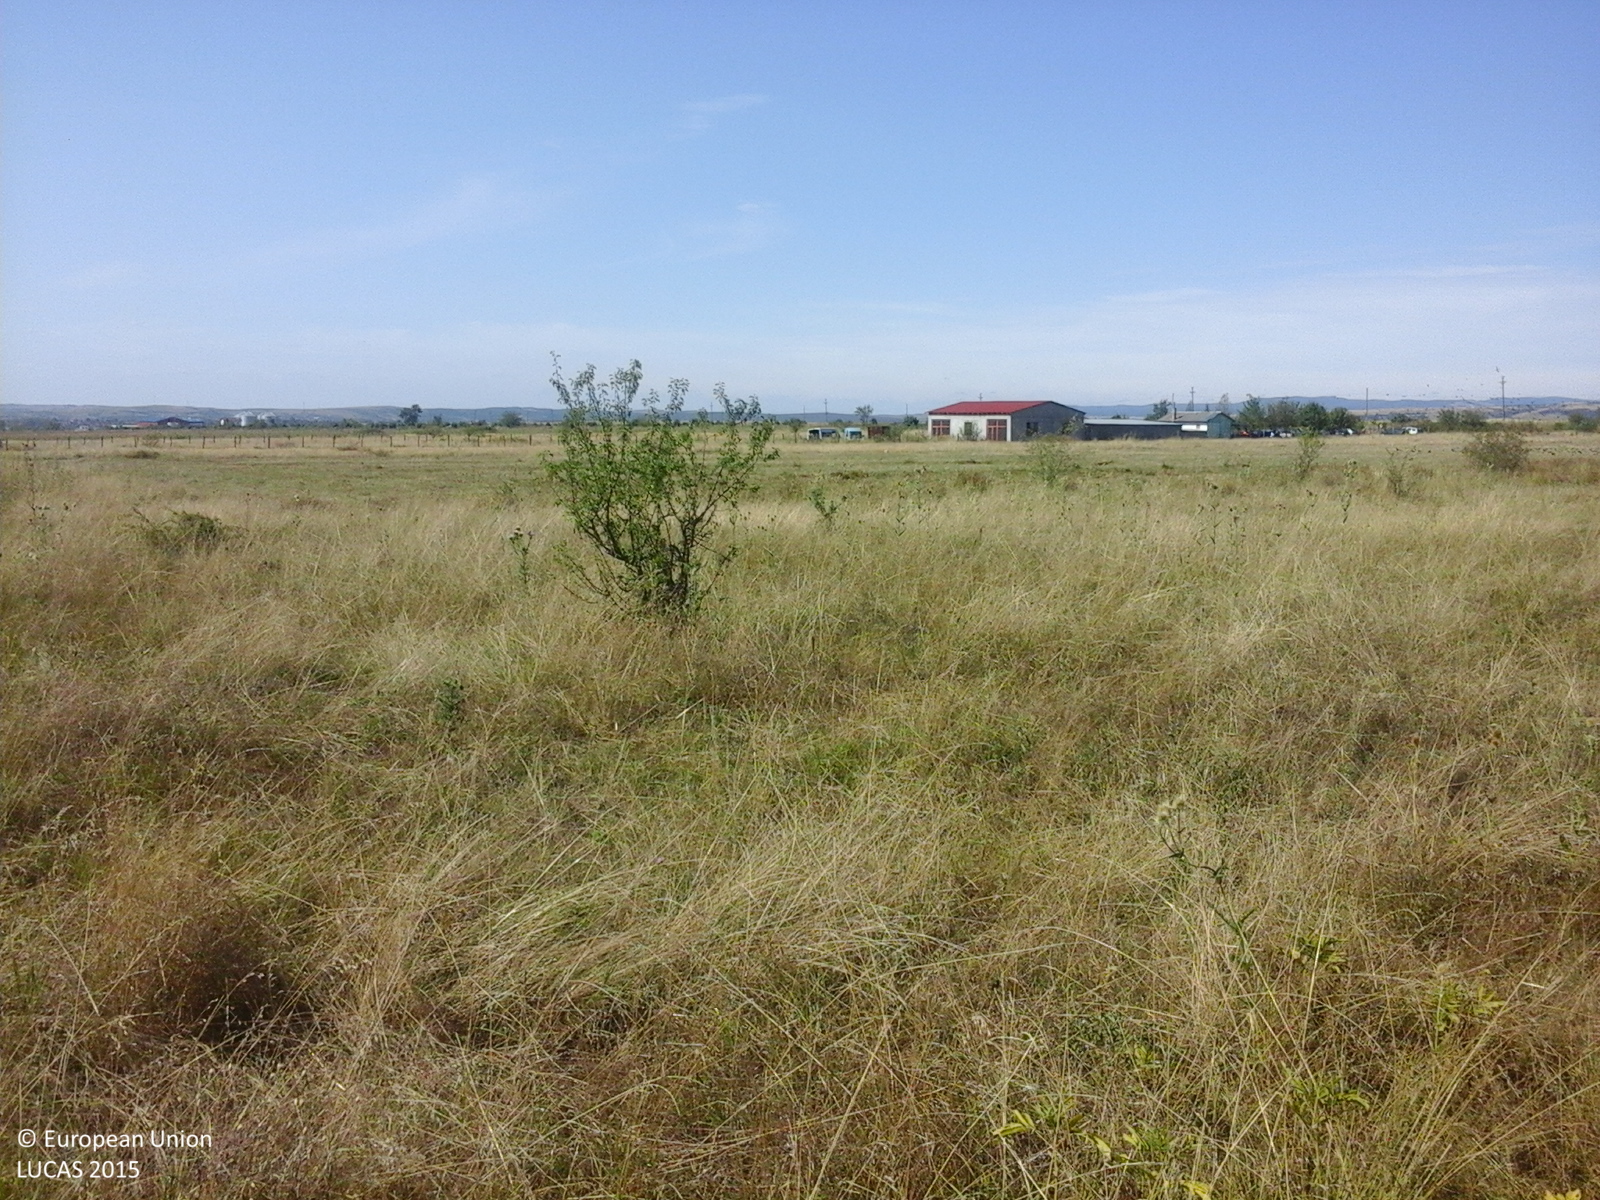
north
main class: Grassland
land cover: Grassland with sparse tree/shrub cover
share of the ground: > 75 %
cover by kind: herbaceous plants 85 %, shrubs 10 %, broadleaved forest trees 5 %
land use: Residential
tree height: < 5 m
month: August
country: RO
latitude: 45.0572
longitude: 21.6504
